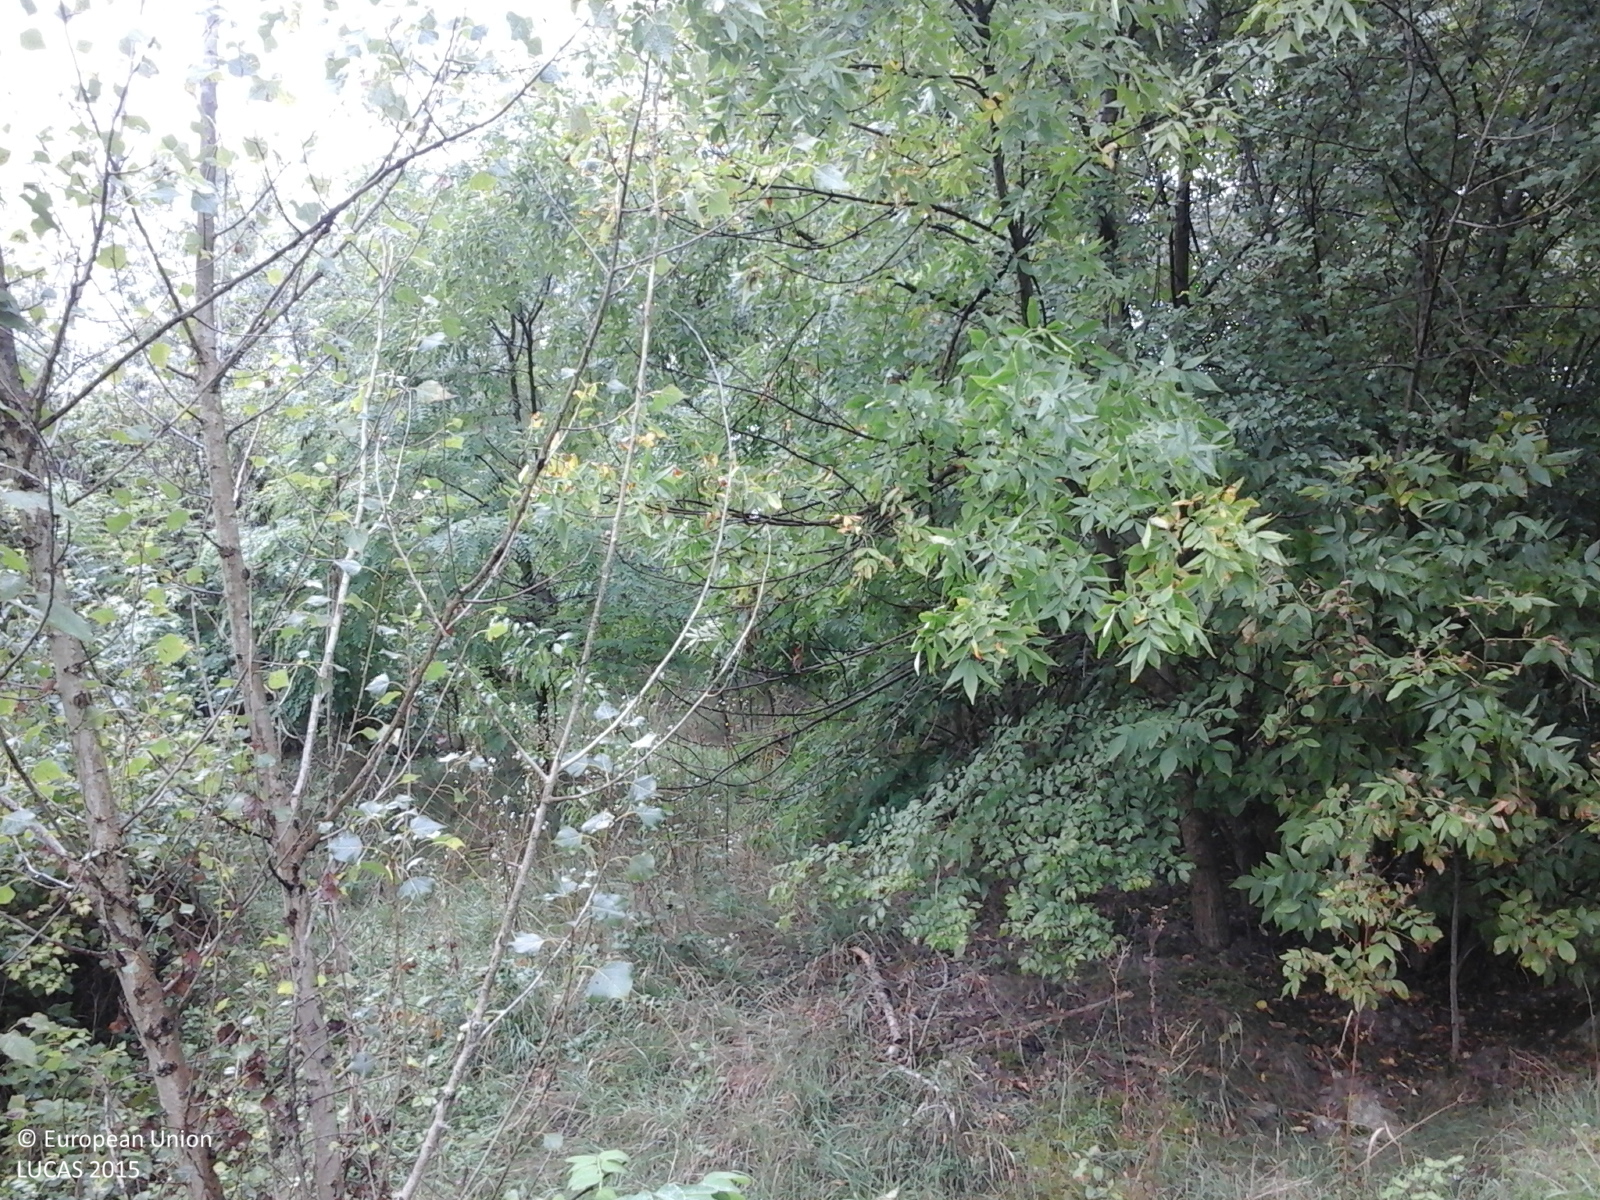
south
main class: Woodland
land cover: Broadleaved woodland
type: exotic forest
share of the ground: > 75 %
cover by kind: broadleaved forest trees 100 %
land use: Forestry
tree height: > 5 m
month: September
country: RO
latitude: 47.0157
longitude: 22.5123
